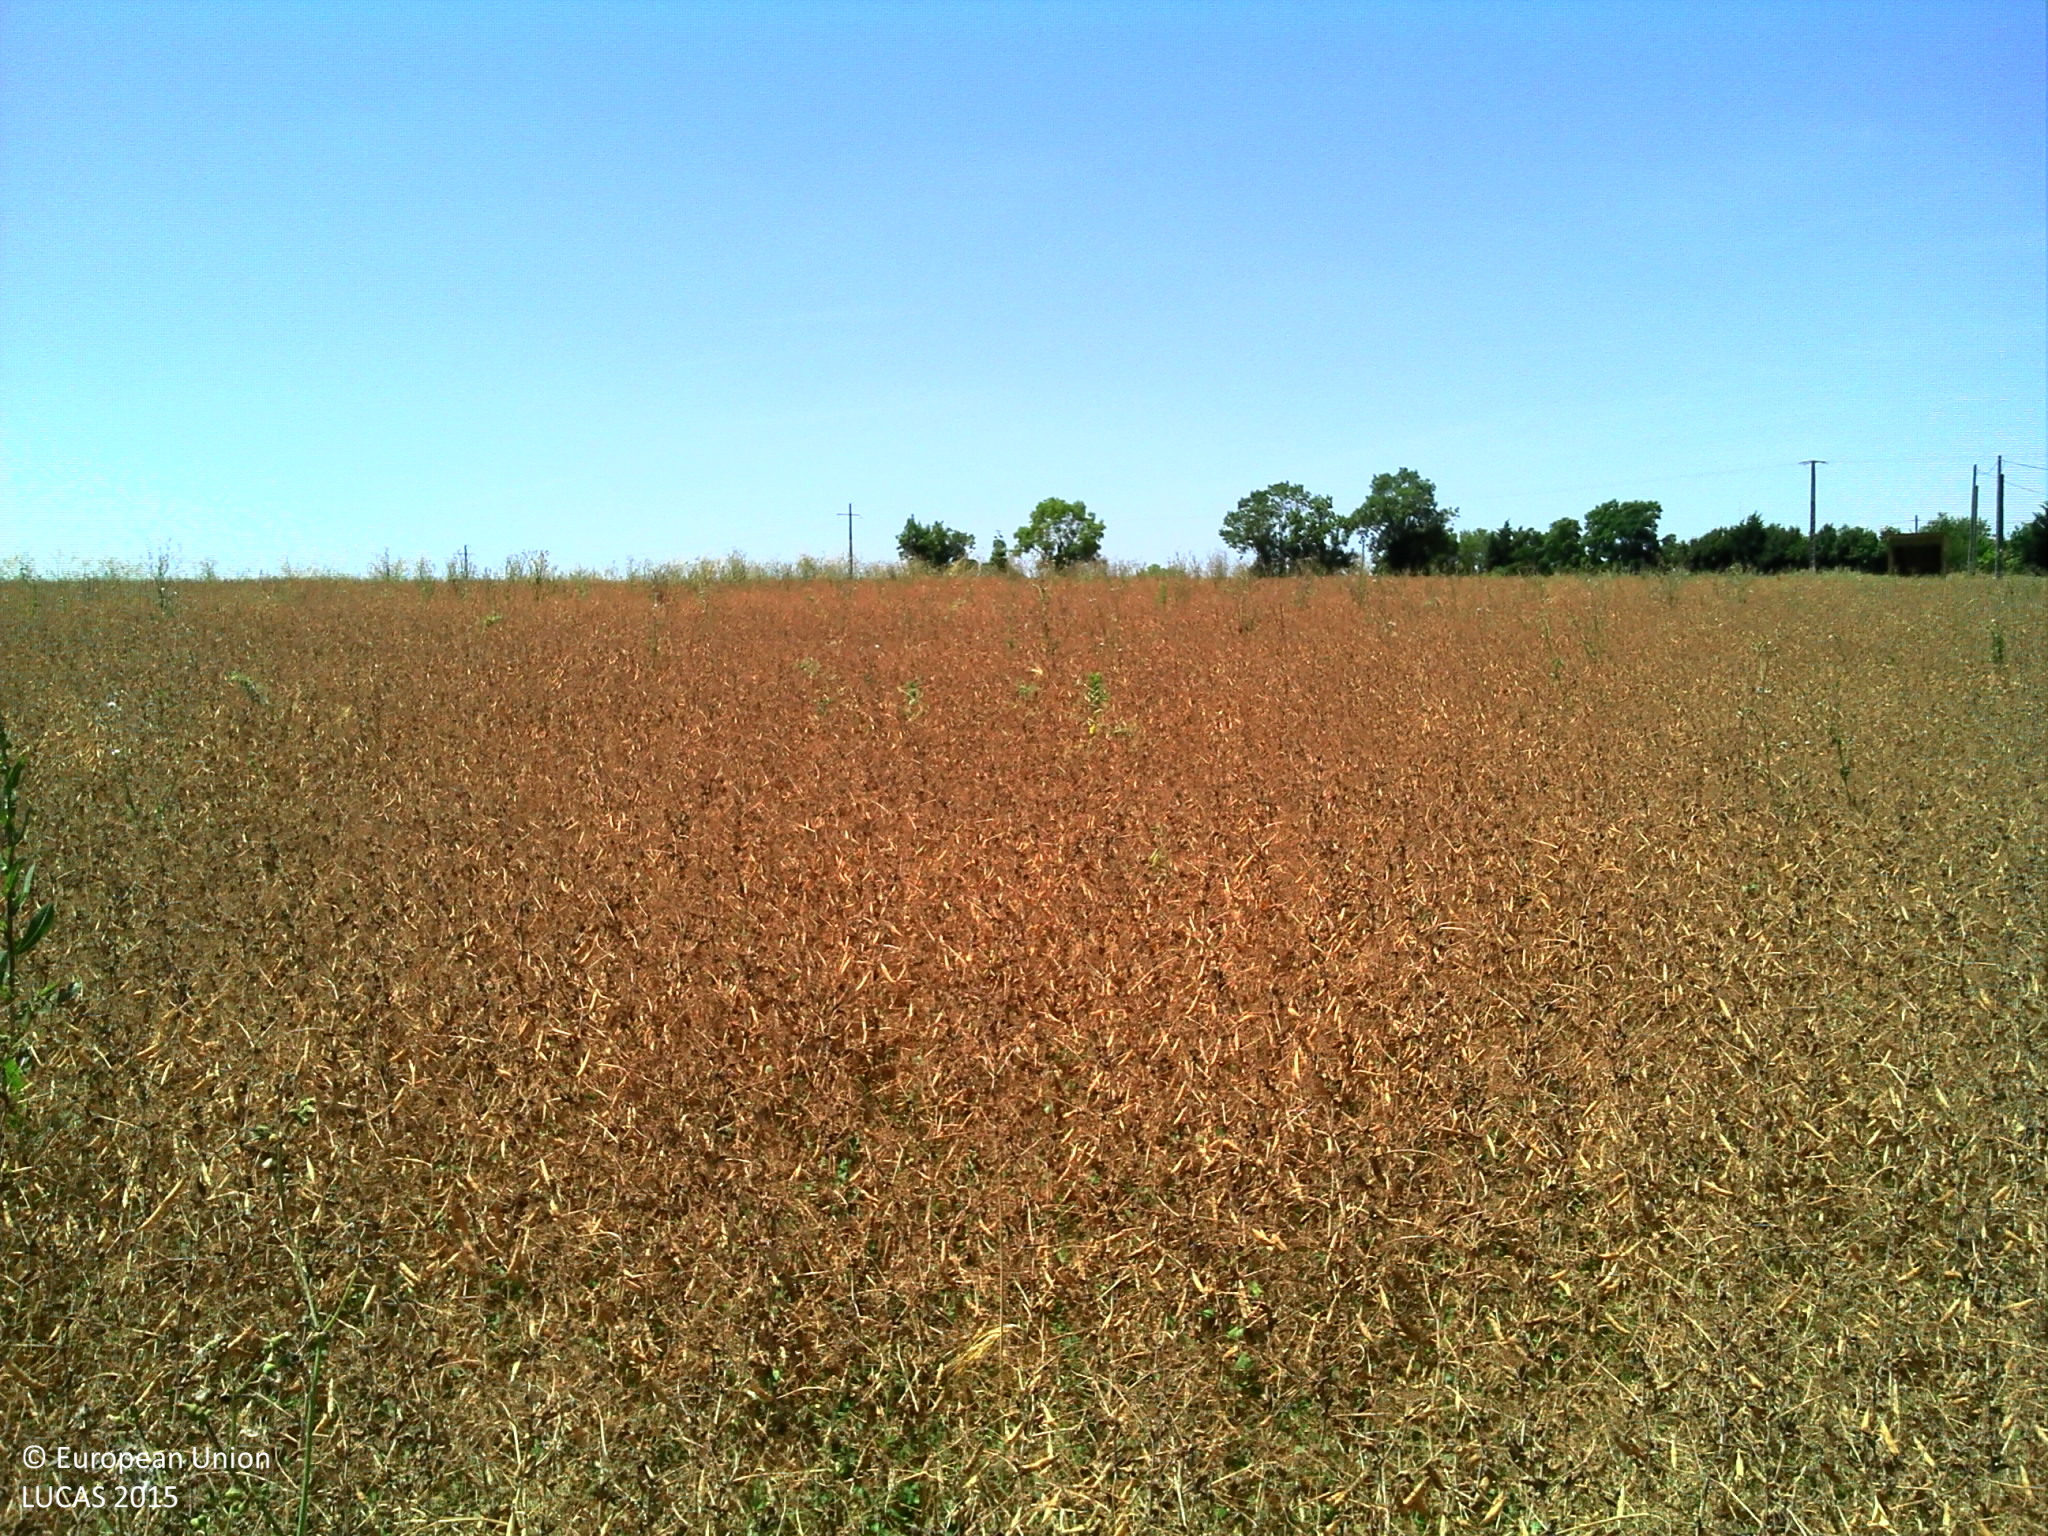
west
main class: Cropland
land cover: Dry pulses
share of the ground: > 75 %
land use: Agriculture (excluding fallow land and kitchen gardens)
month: June
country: FR
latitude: 45.8517
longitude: -0.6753
